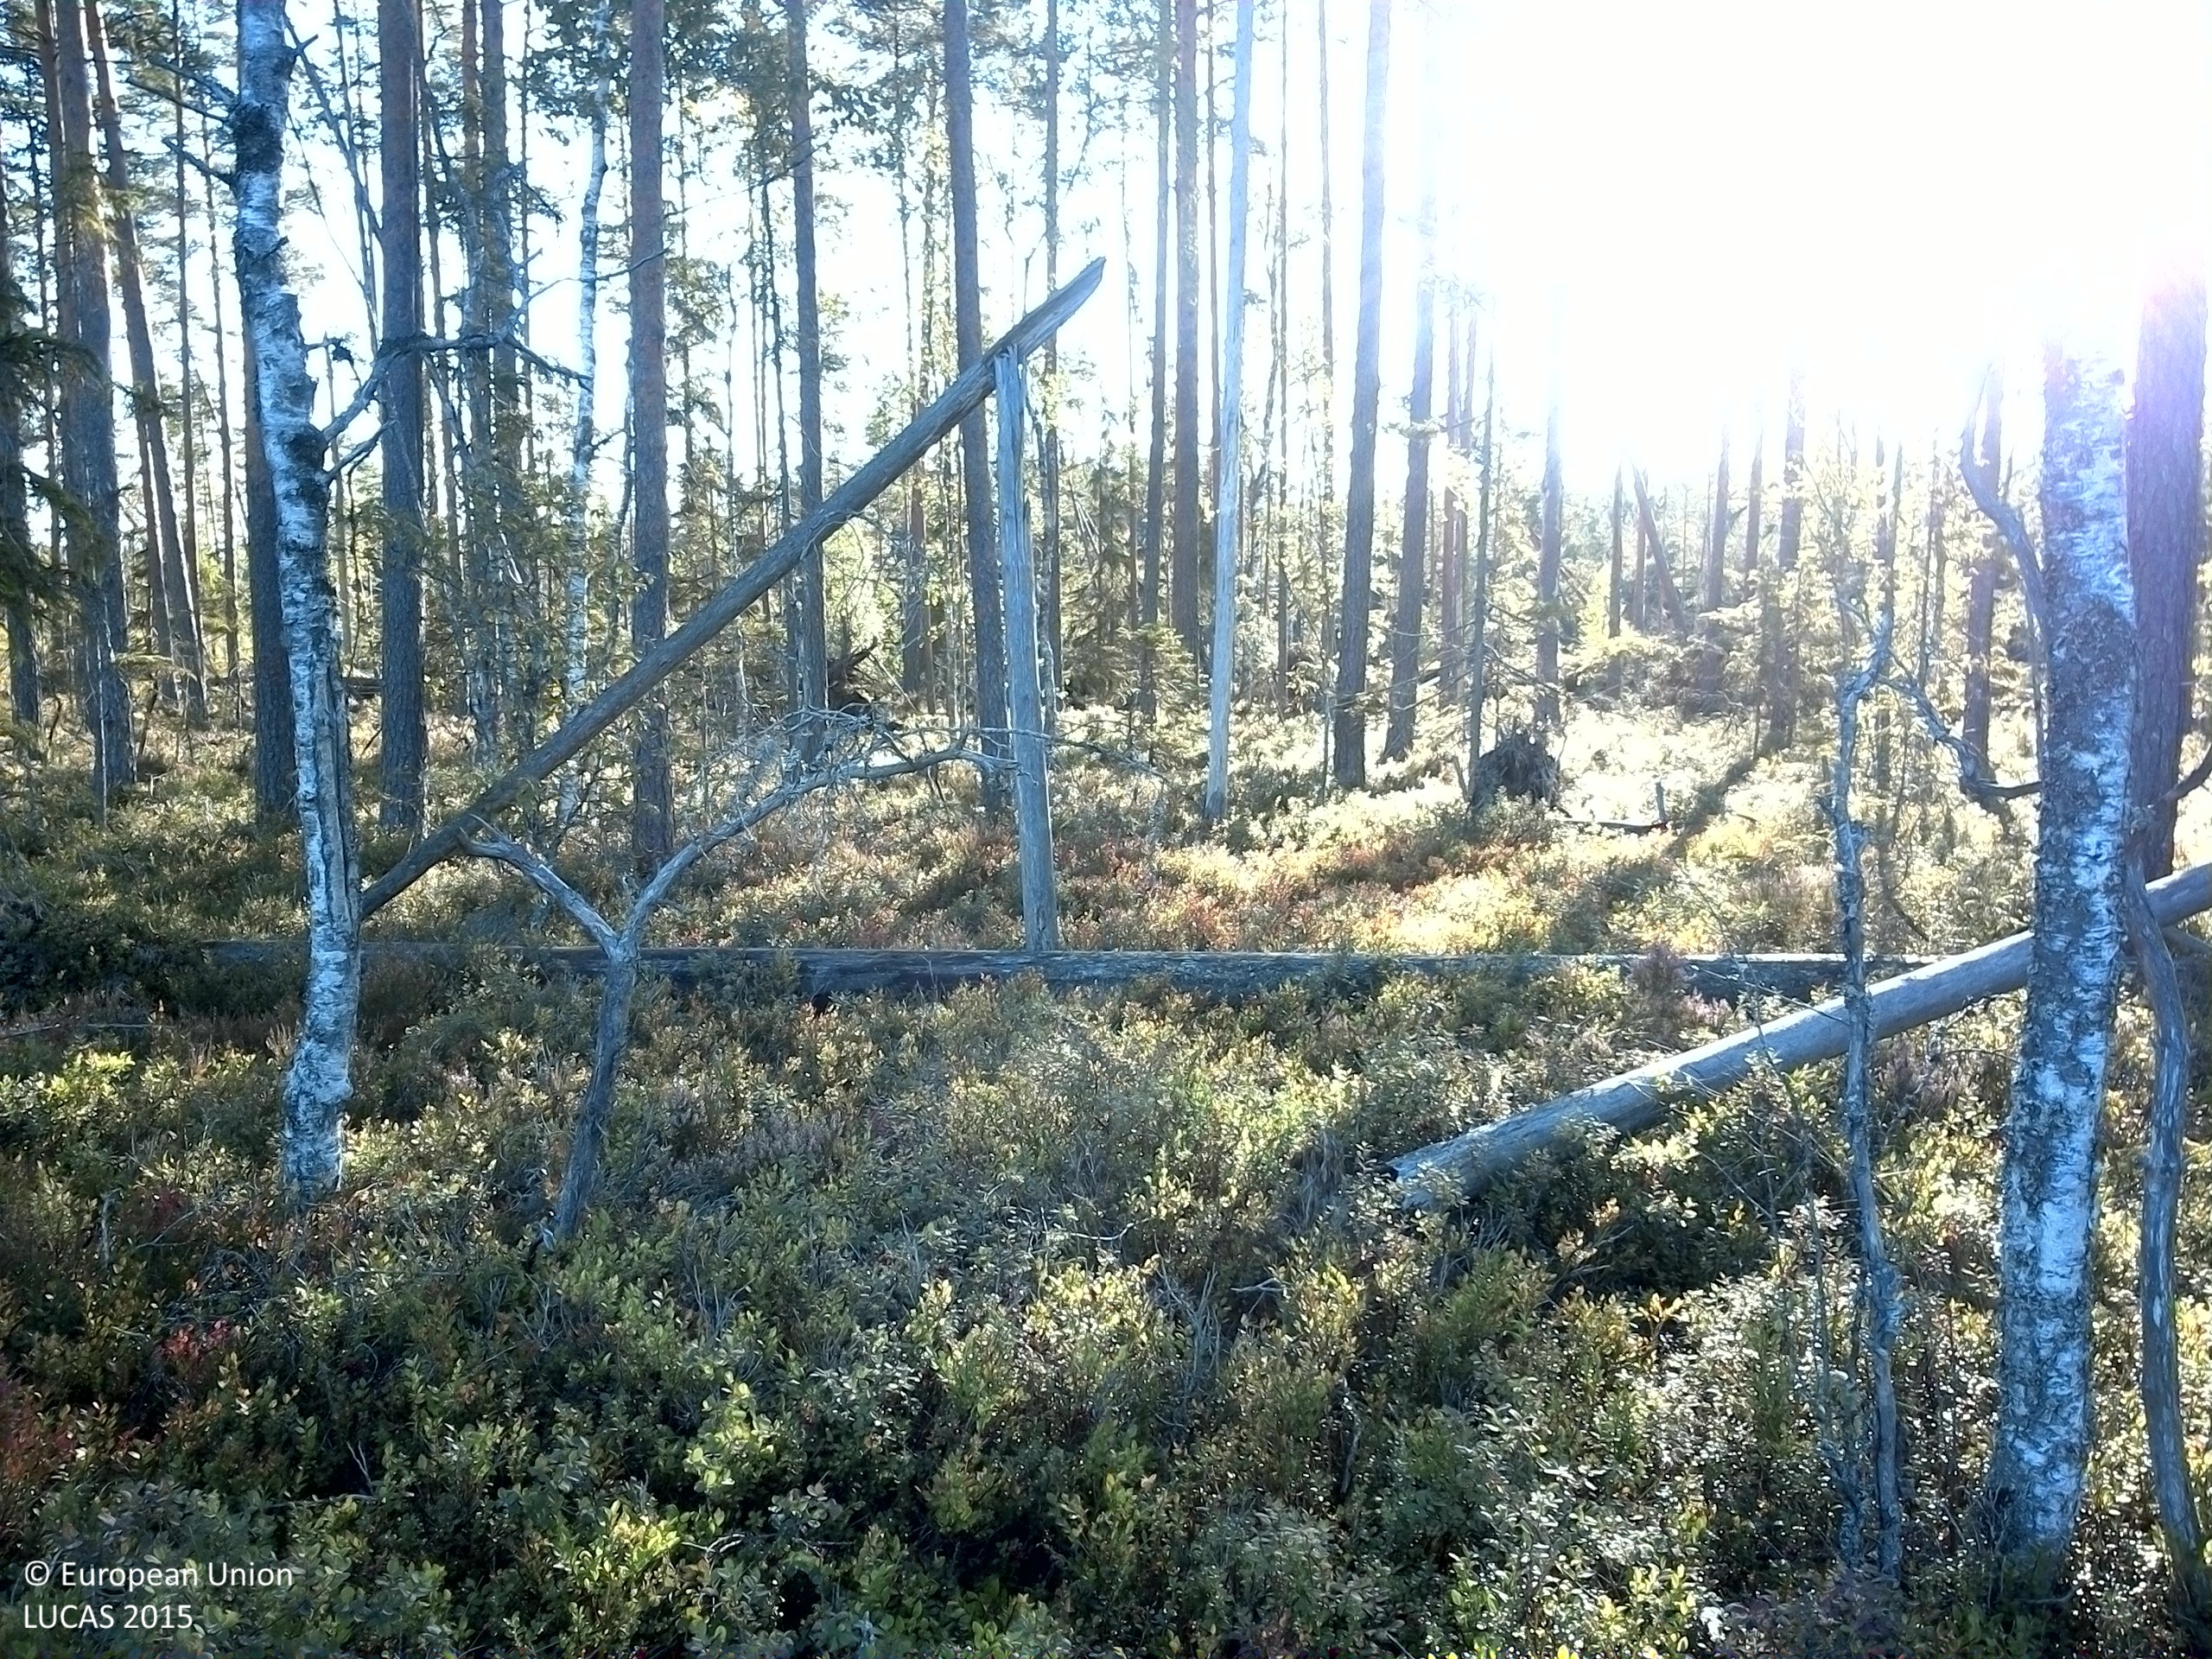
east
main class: Woodland
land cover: Pine dominated coniferous woodland
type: boreal forest
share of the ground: 50 - 75 %
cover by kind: coniferous forest trees 65 %, shrubs 25 %, broadleaved forest trees 5 %, lichens and mosses 5 %
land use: Forestry
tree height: > 5 m
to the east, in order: Pine dominated coniferous woodland; Peatbogs; Inland fresh water bodies; Peatbogs; Pine dominated coniferous woodland; Spruce dominated coniferous woodland
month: September
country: SE
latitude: 59.8334
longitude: 13.3989
